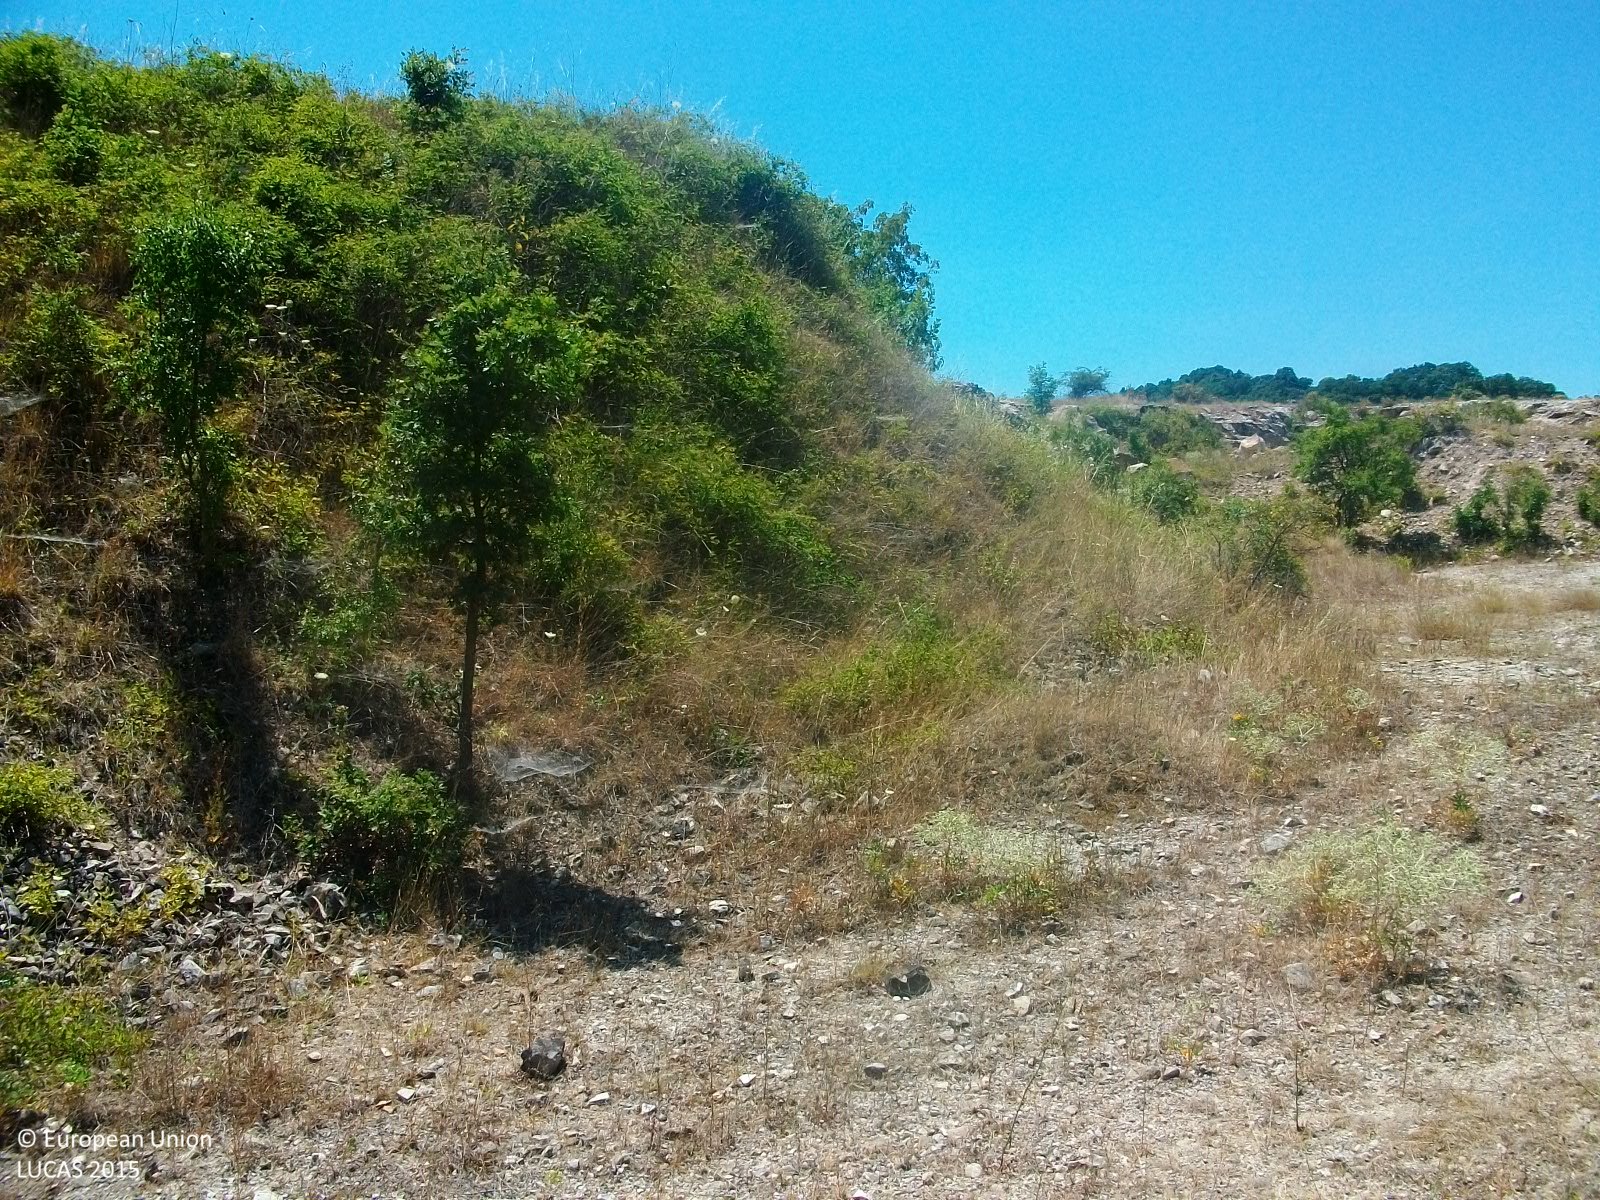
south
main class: Woodland
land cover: Broadleaved woodland
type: thermophilous deciduous forest
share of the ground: 50 - 75 %
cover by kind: broadleaved forest trees 60 %, shrubs 40 %
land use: Semi-natural and natural areas not in use
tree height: > 5 m
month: July
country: GR
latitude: 41.4293
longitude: 26.2142
